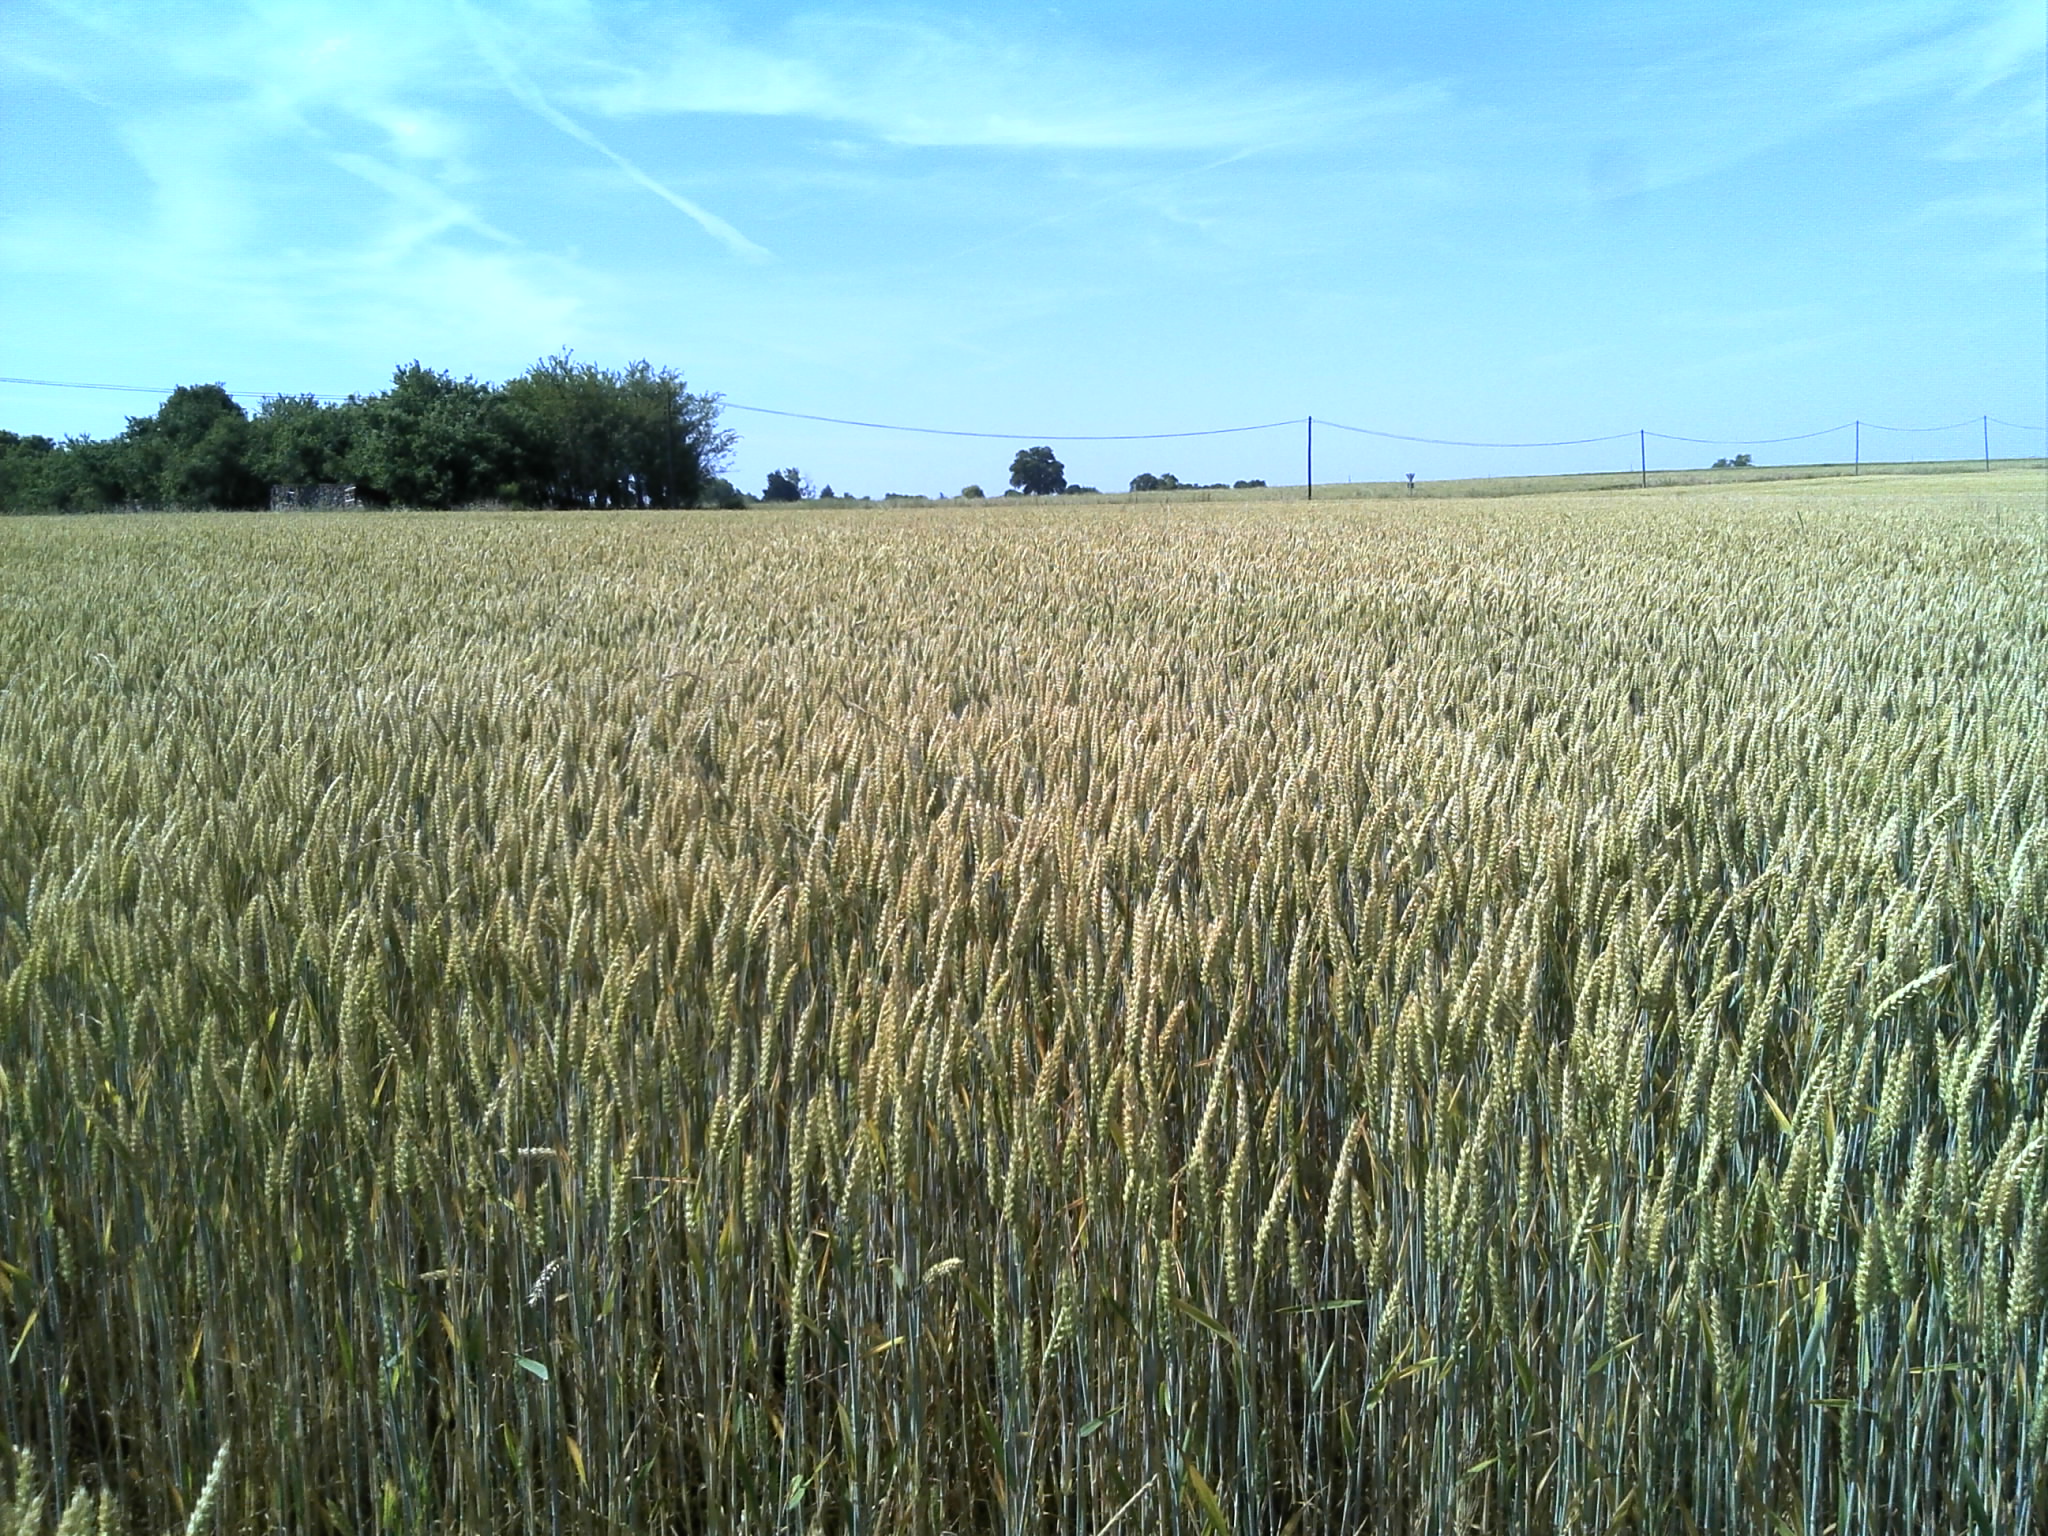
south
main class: Cropland
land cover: Common wheat
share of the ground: > 75 %
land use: Agriculture (excluding fallow land and kitchen gardens)
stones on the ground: < 10 %
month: June
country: FR
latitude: 47.1809
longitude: 1.3962
